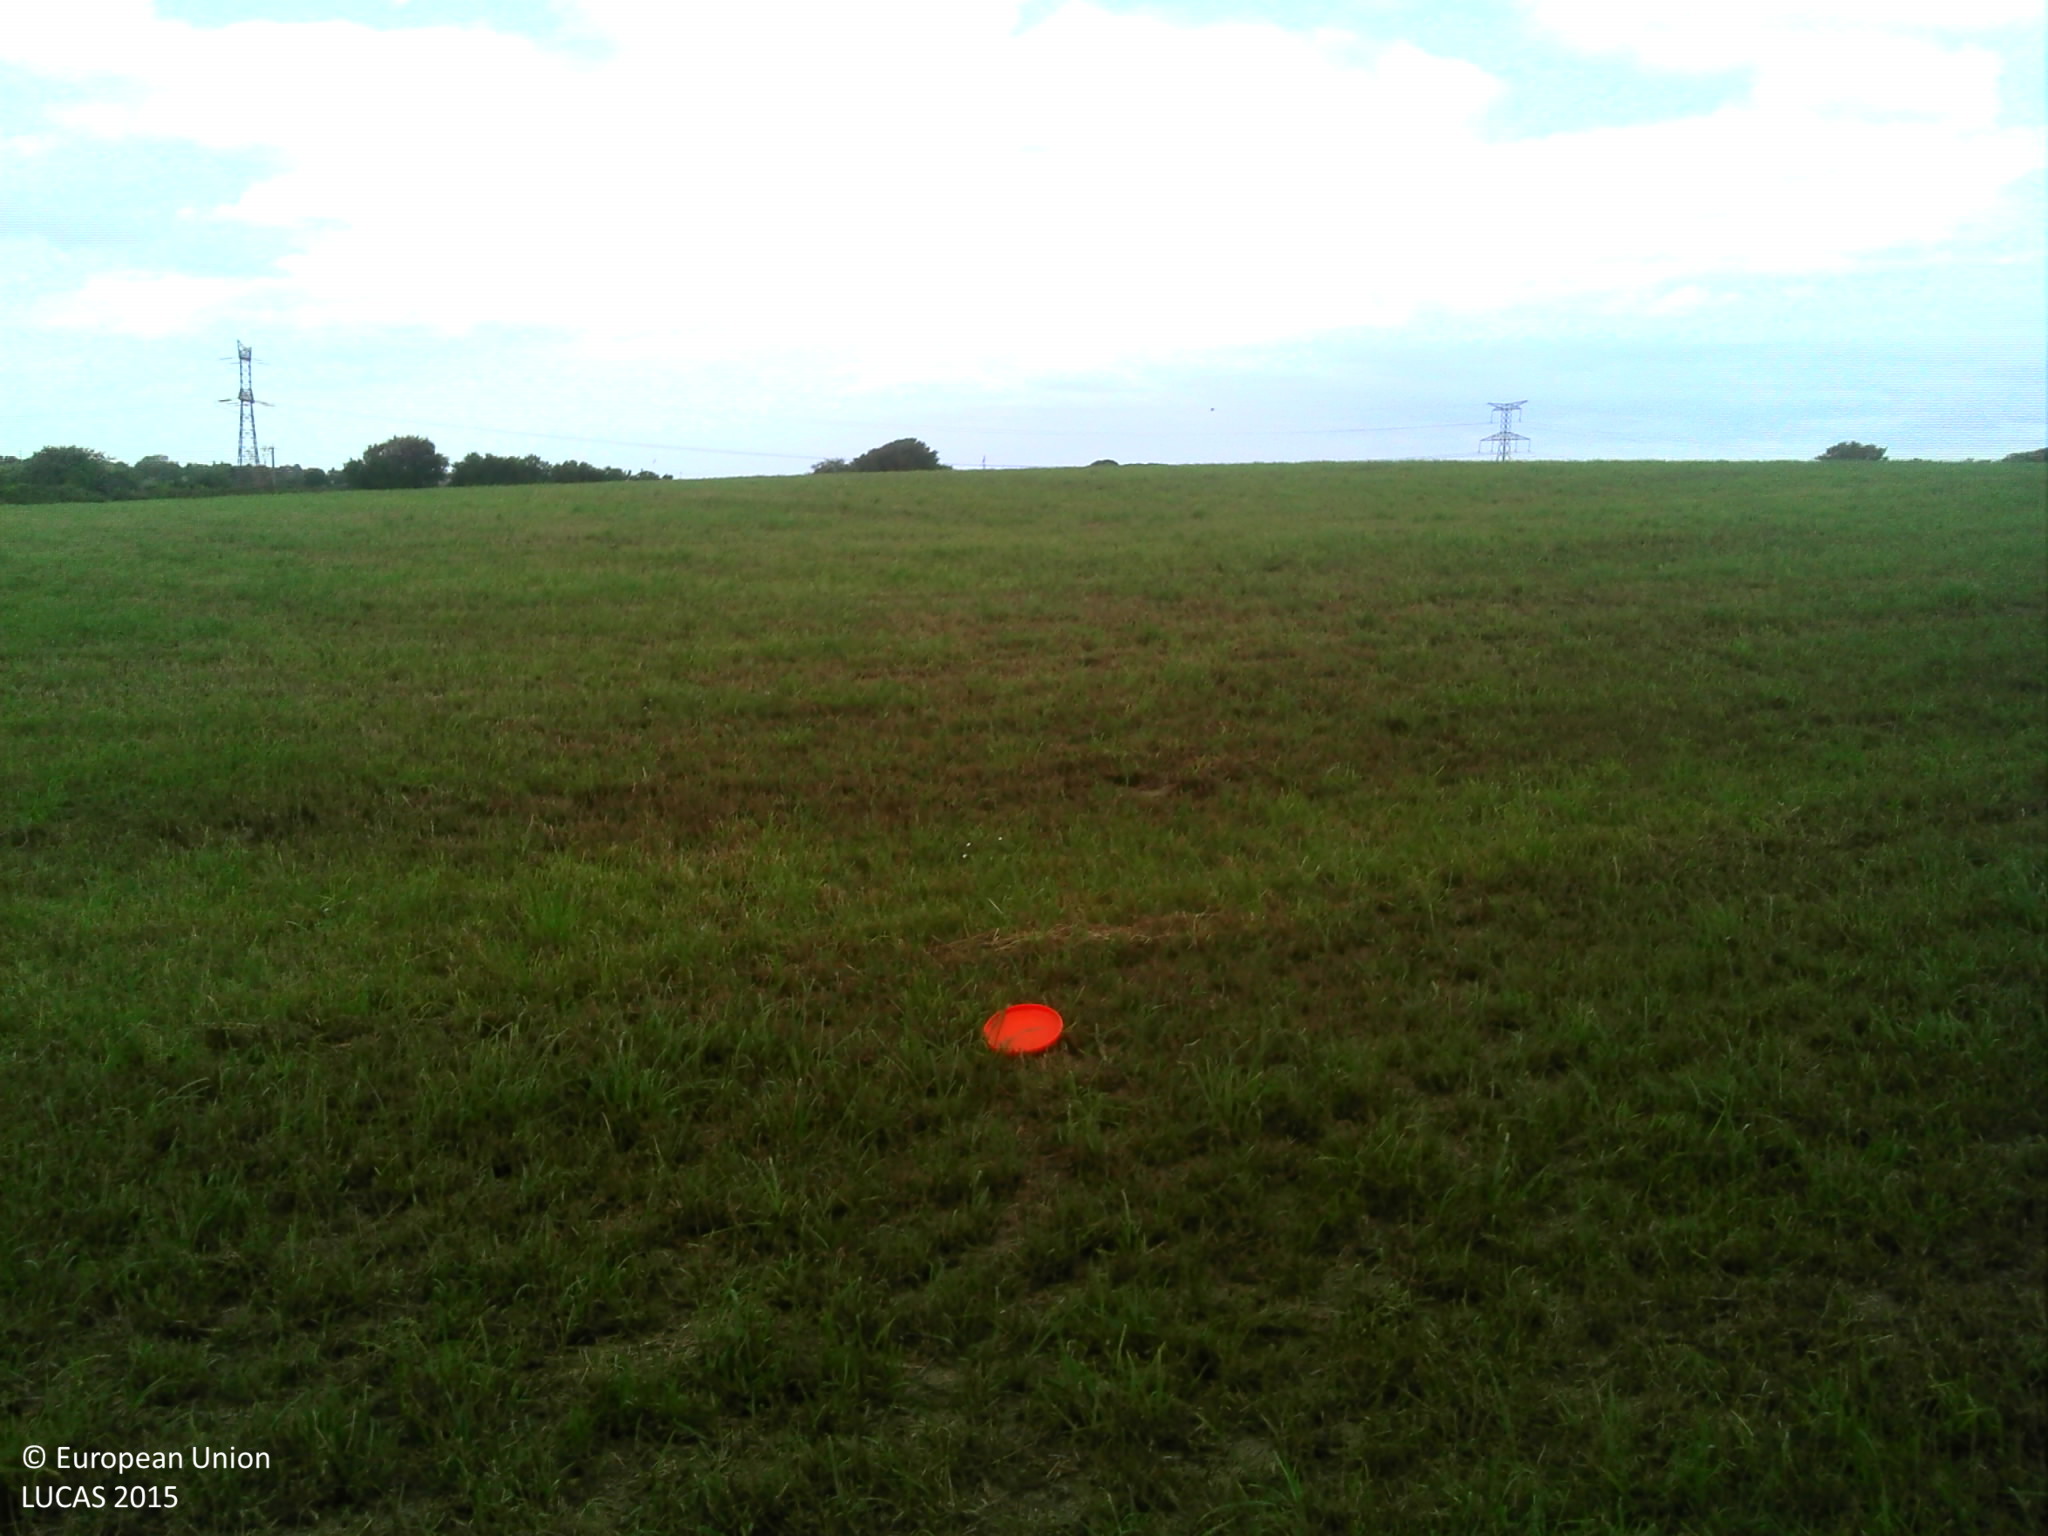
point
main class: Grassland
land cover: Grassland without tree/shrub cover
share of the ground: > 75 %
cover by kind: herbaceous plants 100 %
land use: Agriculture (excluding fallow land and kitchen gardens)
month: June
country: FR
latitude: 49.6583
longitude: -1.8152
